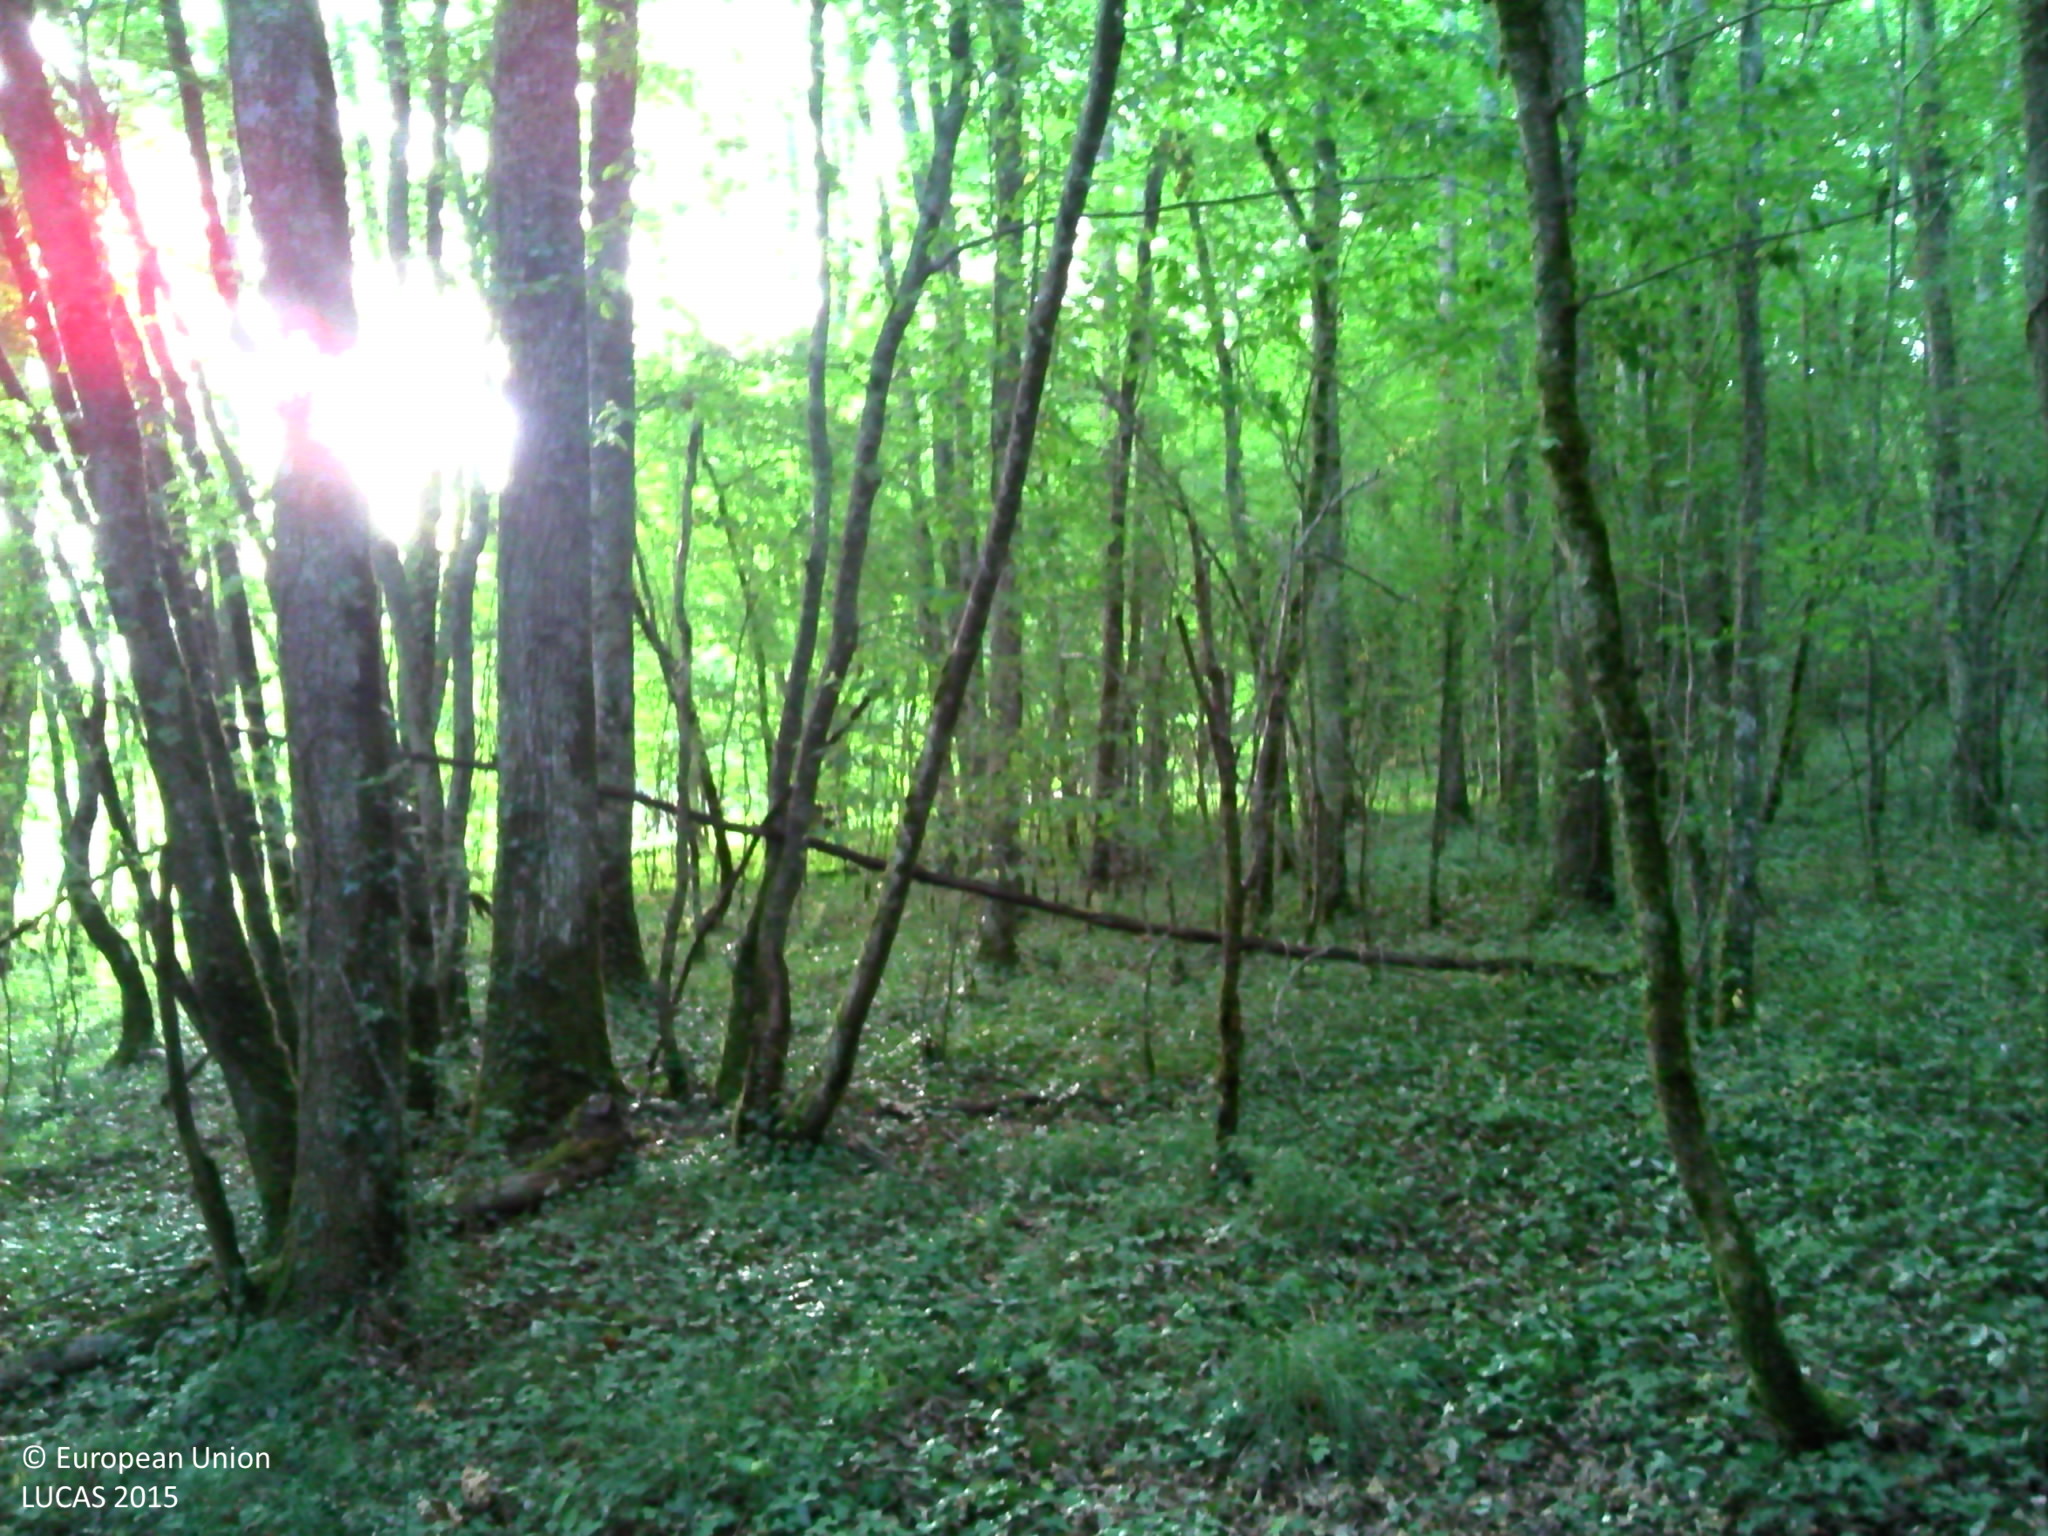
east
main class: Woodland
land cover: Broadleaved woodland
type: acidophilous oak and oak-birch forest
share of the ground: > 75 %
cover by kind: broadleaved forest trees 75 %, herbaceous plants 20 %, shrubs 5 %
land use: Forestry
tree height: > 5 m
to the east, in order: Broadleaved woodland; Fences; Dry stone walls; Broadleaved woodland; Fences; Broadleaved woodland; Grassland without tree/shrub cover; Spontaneously vegetated surfaces; Broadleaved woodland
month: July
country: FR
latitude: 44.8608
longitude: 0.9447
